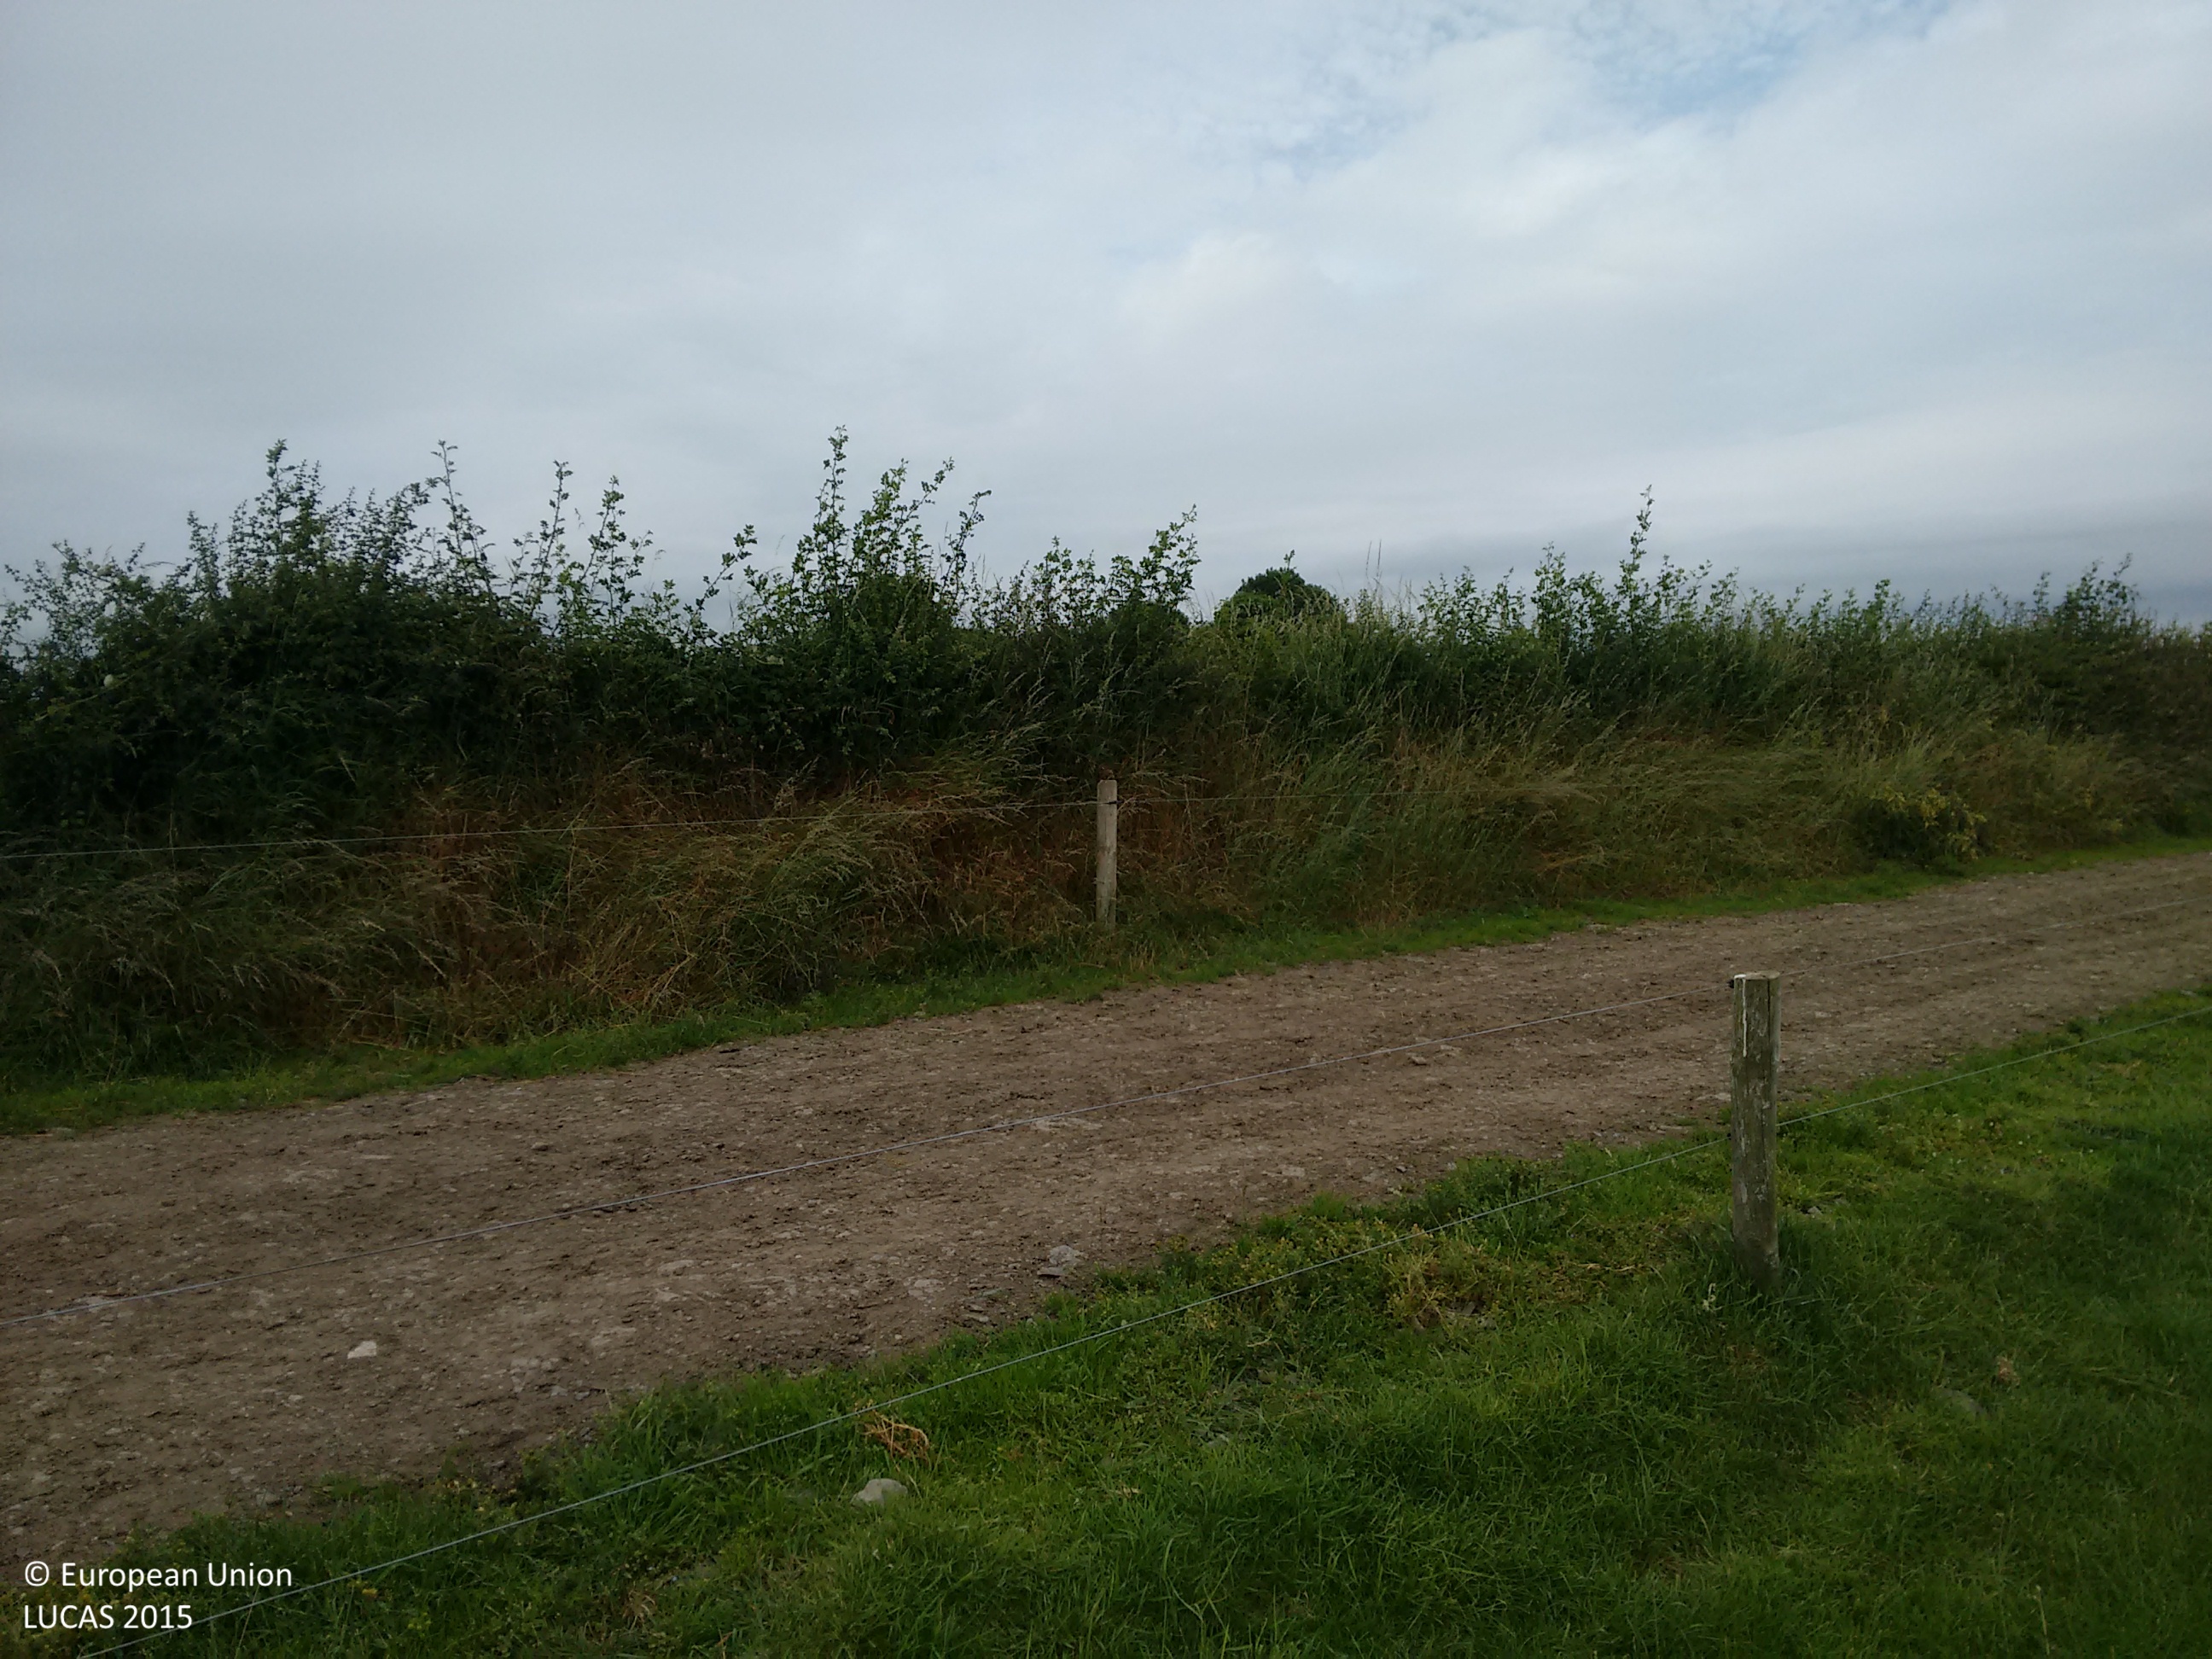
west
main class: Grassland
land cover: Grassland without tree/shrub cover
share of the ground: > 75 %
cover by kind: herbaceous plants 100 %
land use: Agriculture (excluding fallow land and kitchen gardens)
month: July
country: IE
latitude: 52.7127
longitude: -7.5535
